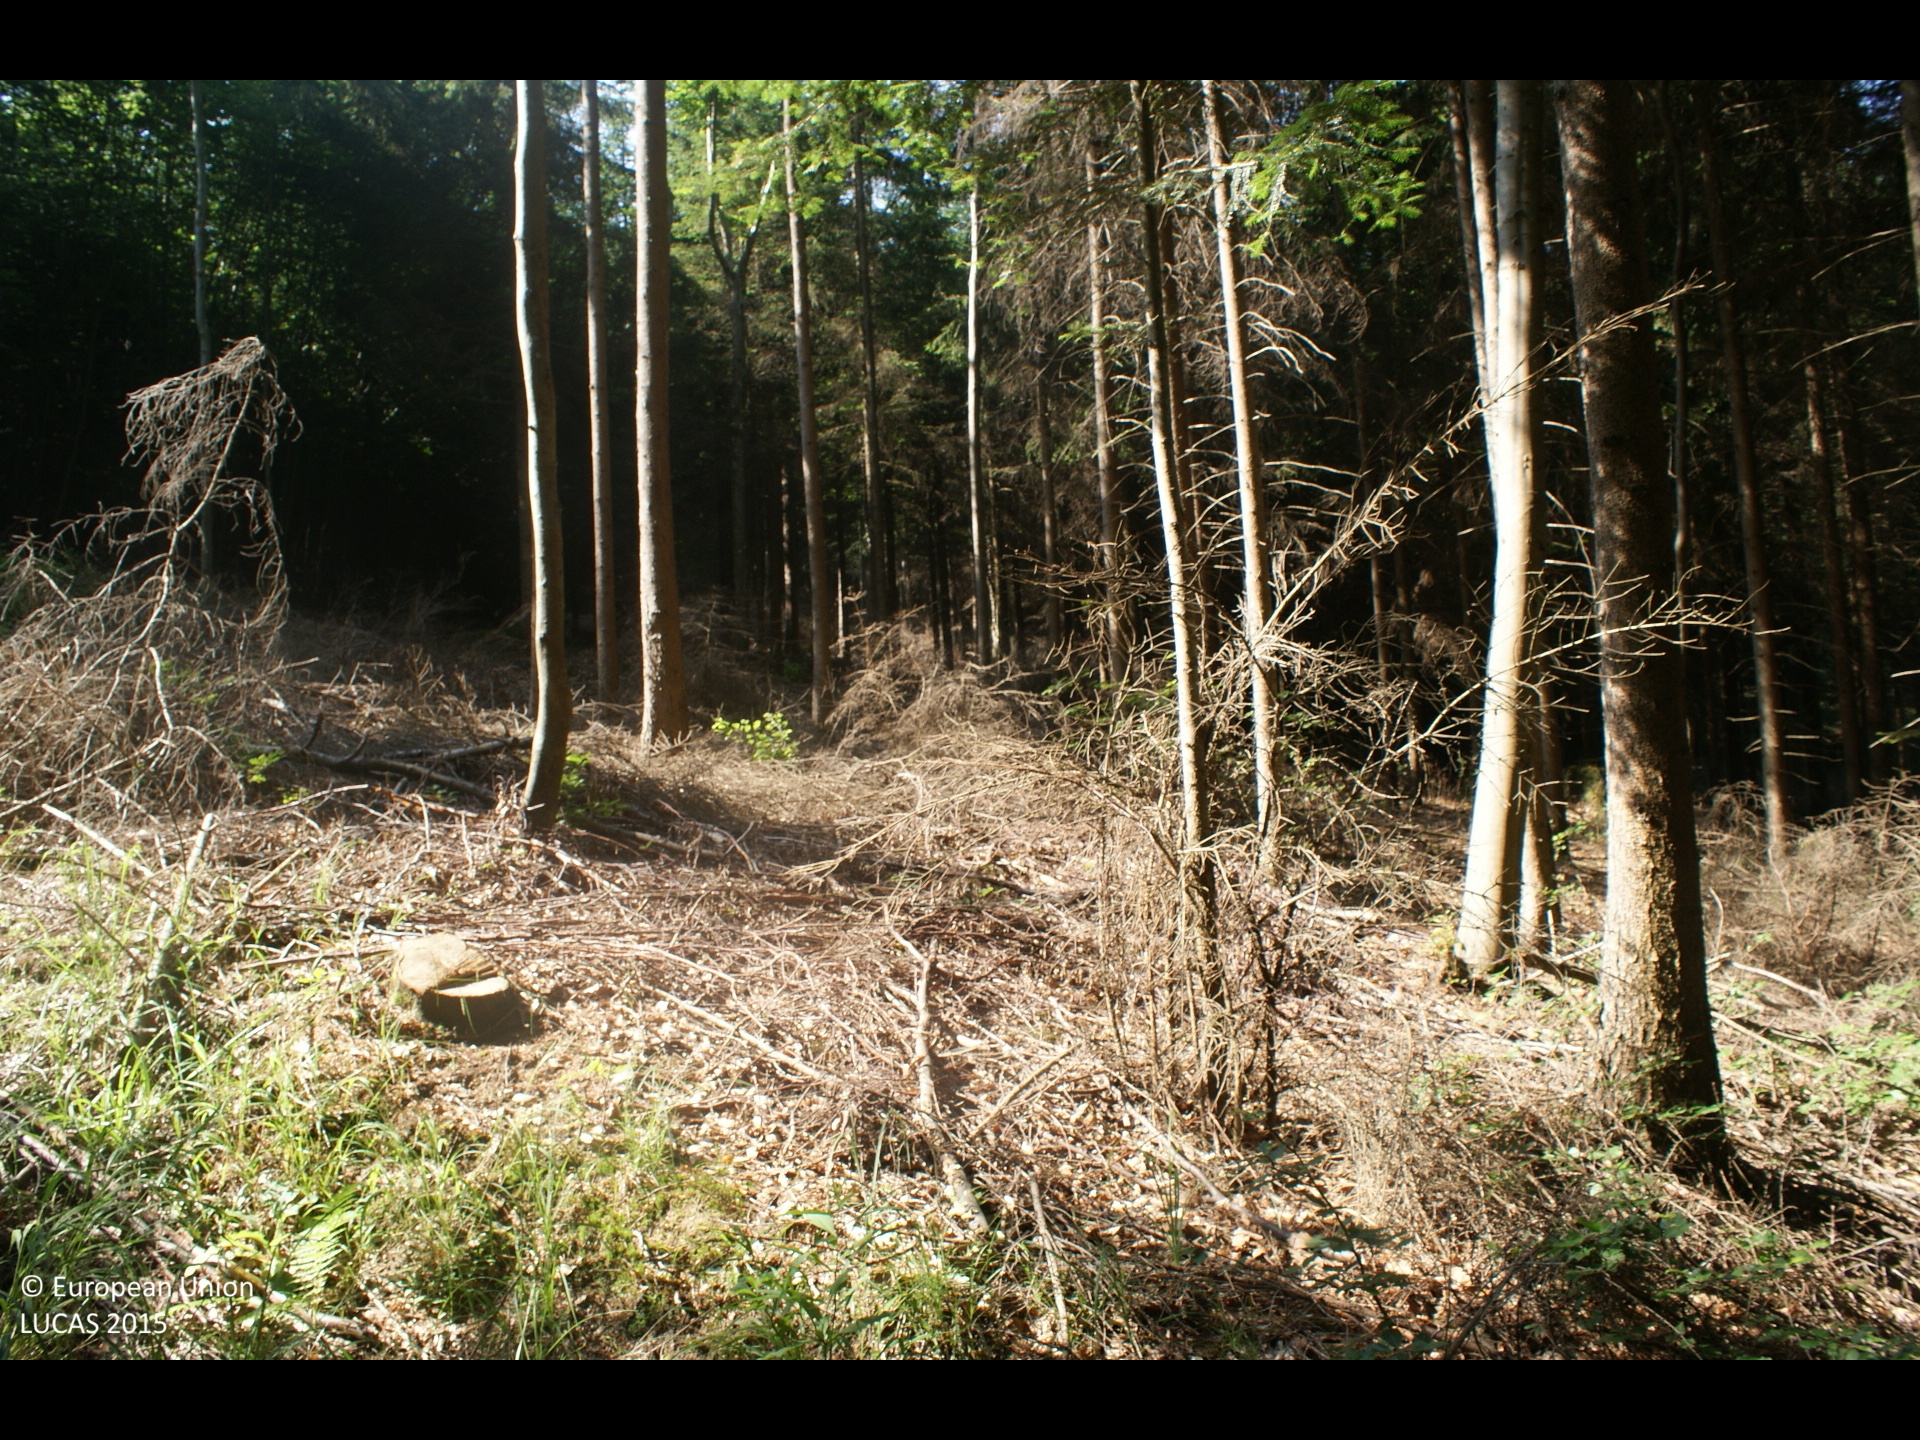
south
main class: Woodland
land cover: Spruce dominated mixed woodland
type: mountainous beech forest
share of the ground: > 75 %
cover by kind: coniferous forest trees 70 %, broadleaved forest trees 30 %
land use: Forestry
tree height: > 5 m
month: July
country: AT
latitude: 47.9288
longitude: 14.1620
